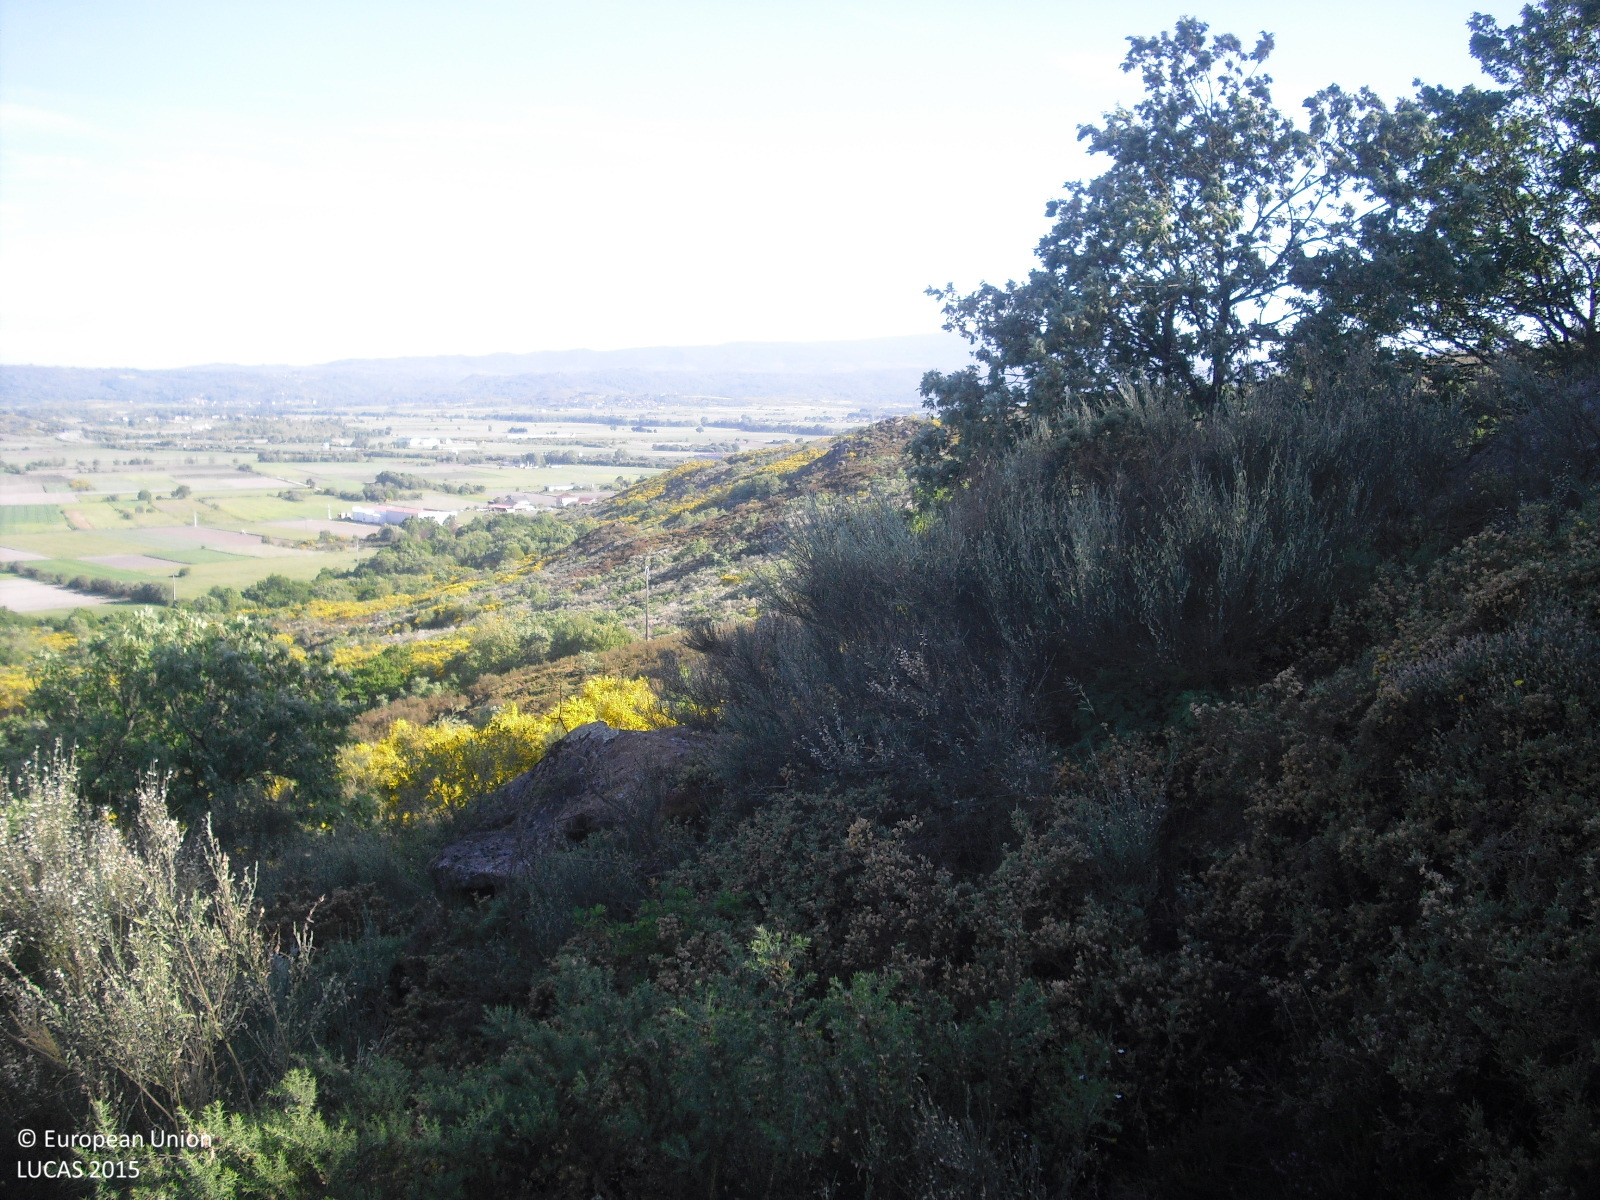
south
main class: Shrubland
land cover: Shrubland with sparse tree cover
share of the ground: > 75 %
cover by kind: shrubs 85 %, consolidated bare surface 10 %, broadleaved forest trees 5 %
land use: Semi-natural and natural areas not in use
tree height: > 5 m
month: May
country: ES
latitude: 42.0799
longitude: -7.6805
